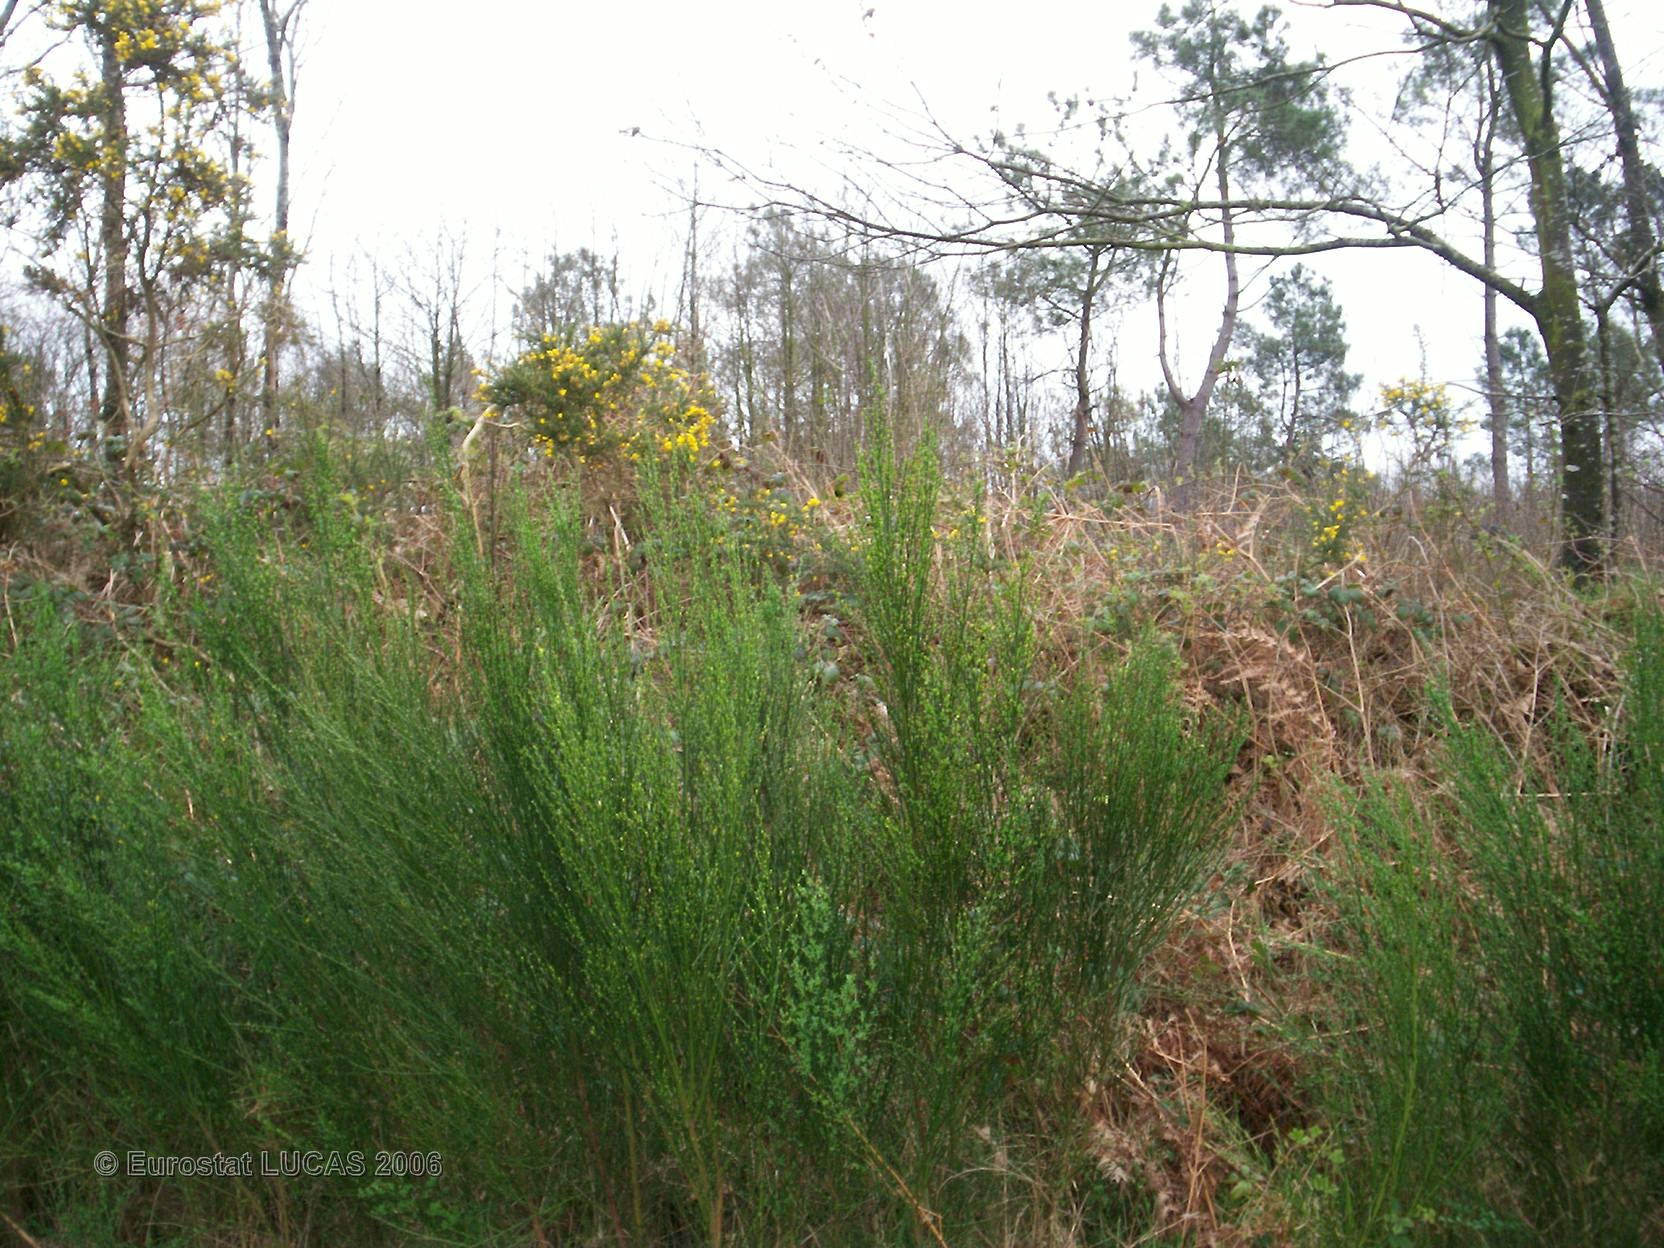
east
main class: Grassland
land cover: Grassland without tree/shrub cover
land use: Agriculture (excluding fallow land and kitchen gardens)
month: April
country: FR
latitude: 47.8114
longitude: -2.8712
